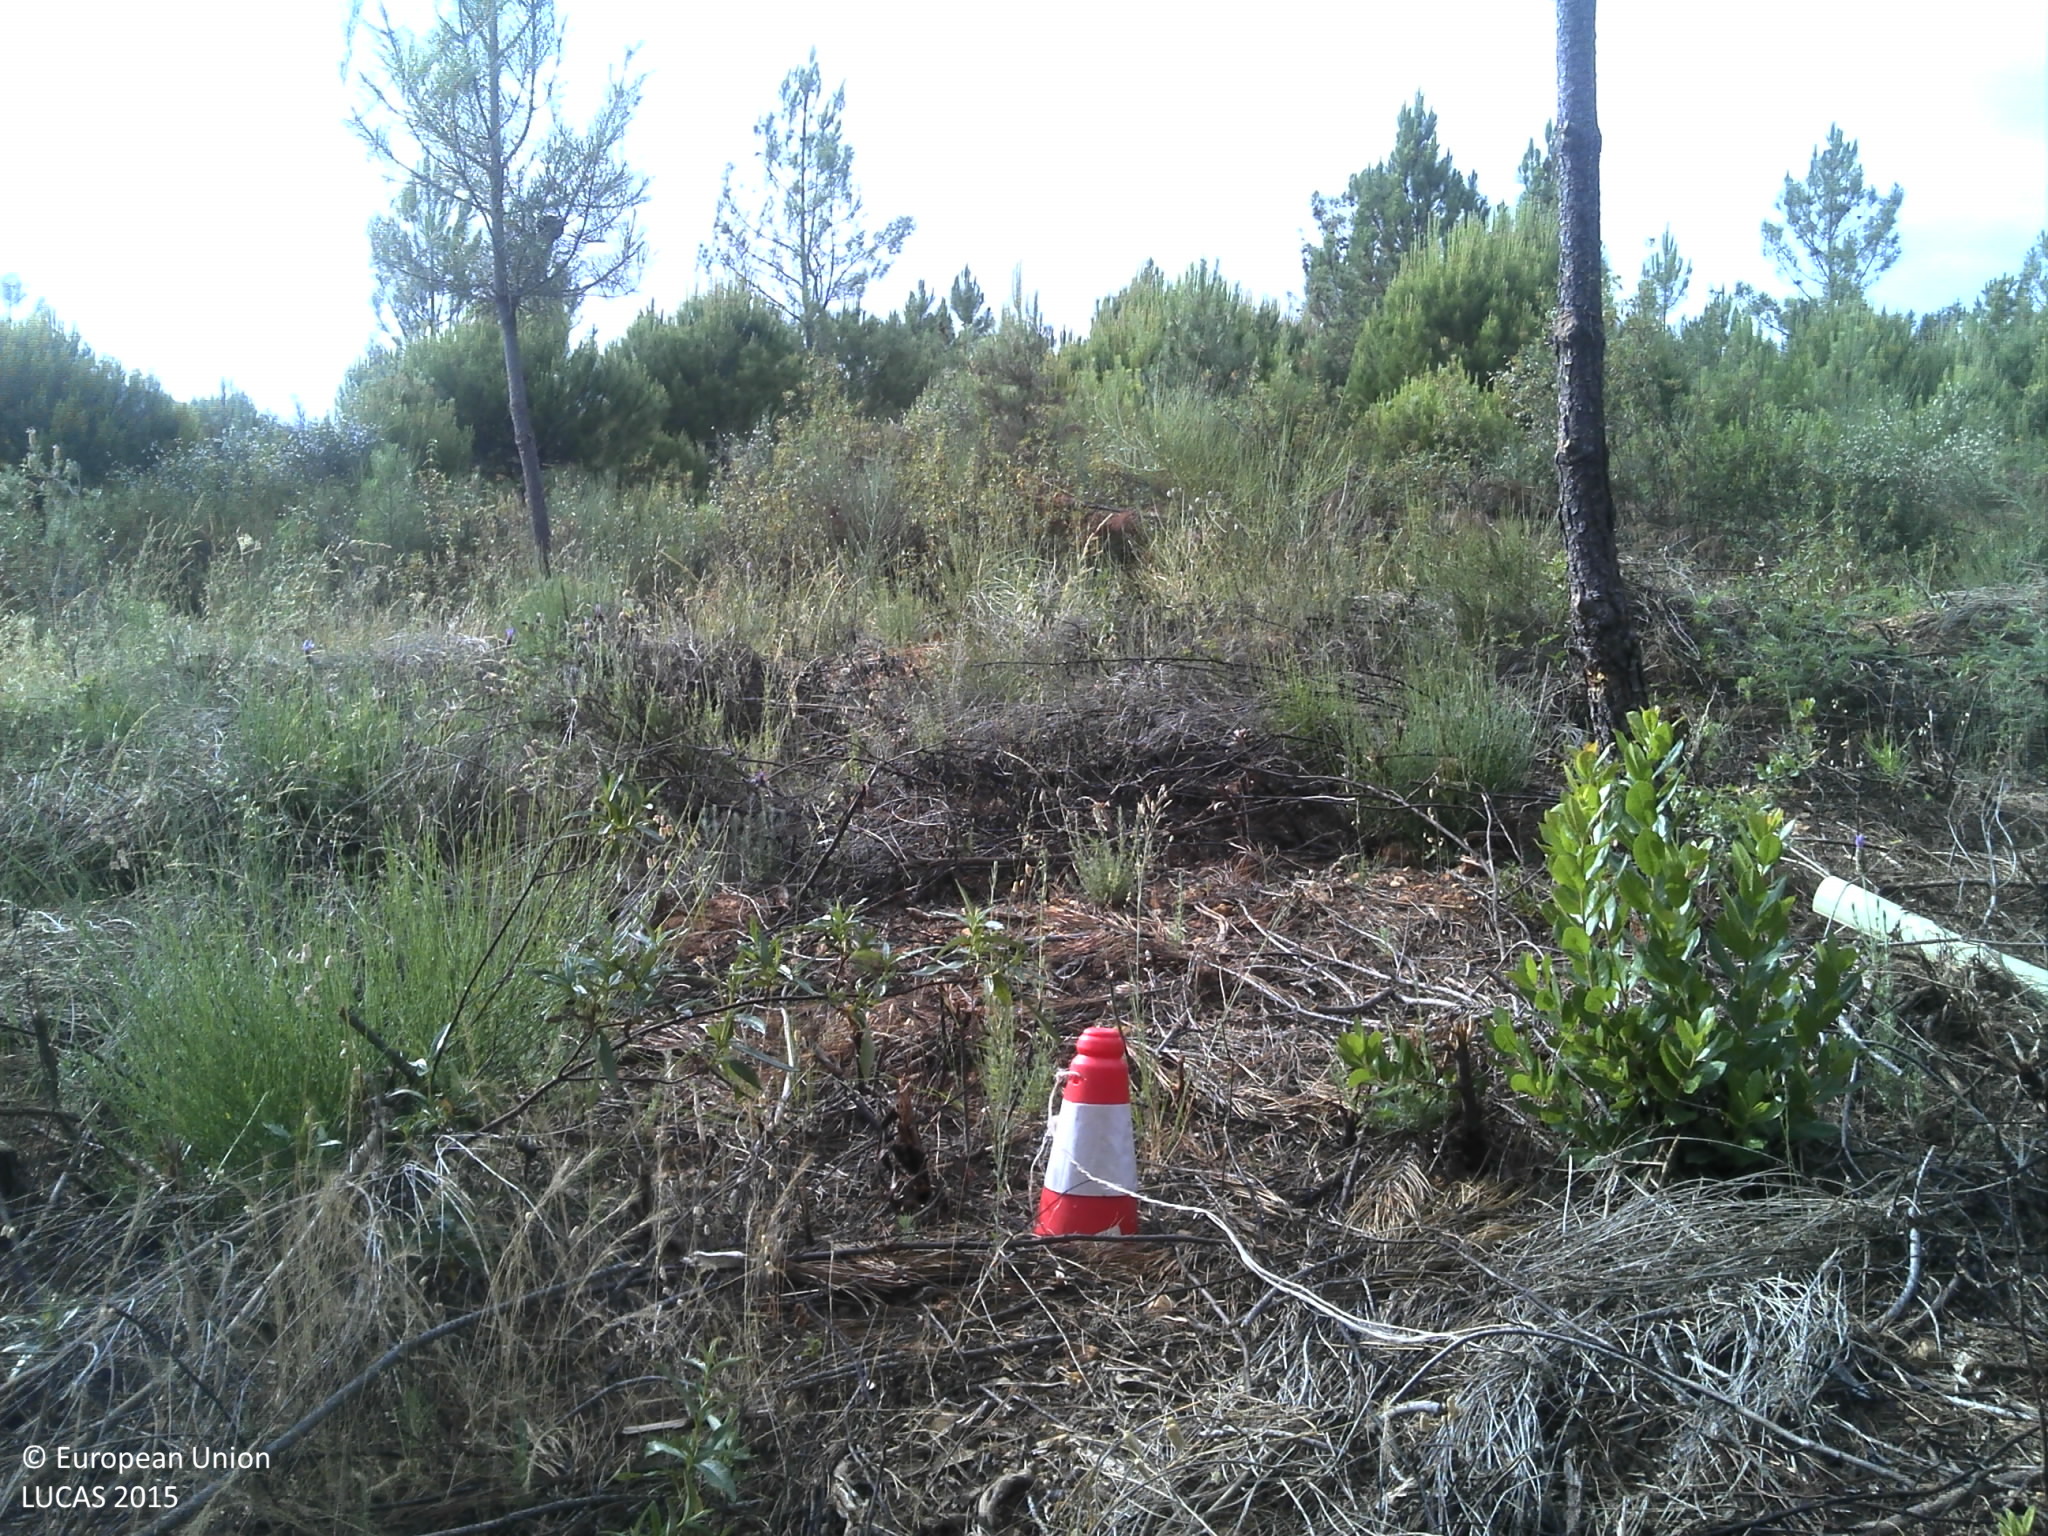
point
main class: Woodland
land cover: Pine dominated coniferous woodland
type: coniferous forest of the mediterranean region
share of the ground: 50 - 75 %
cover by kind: coniferous forest trees 50 %, shrubs 40 %, unconsolidated bare surface 5 %
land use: Forestry
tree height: > 5 m
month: June
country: PT
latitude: 40.2108
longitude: -7.0978
